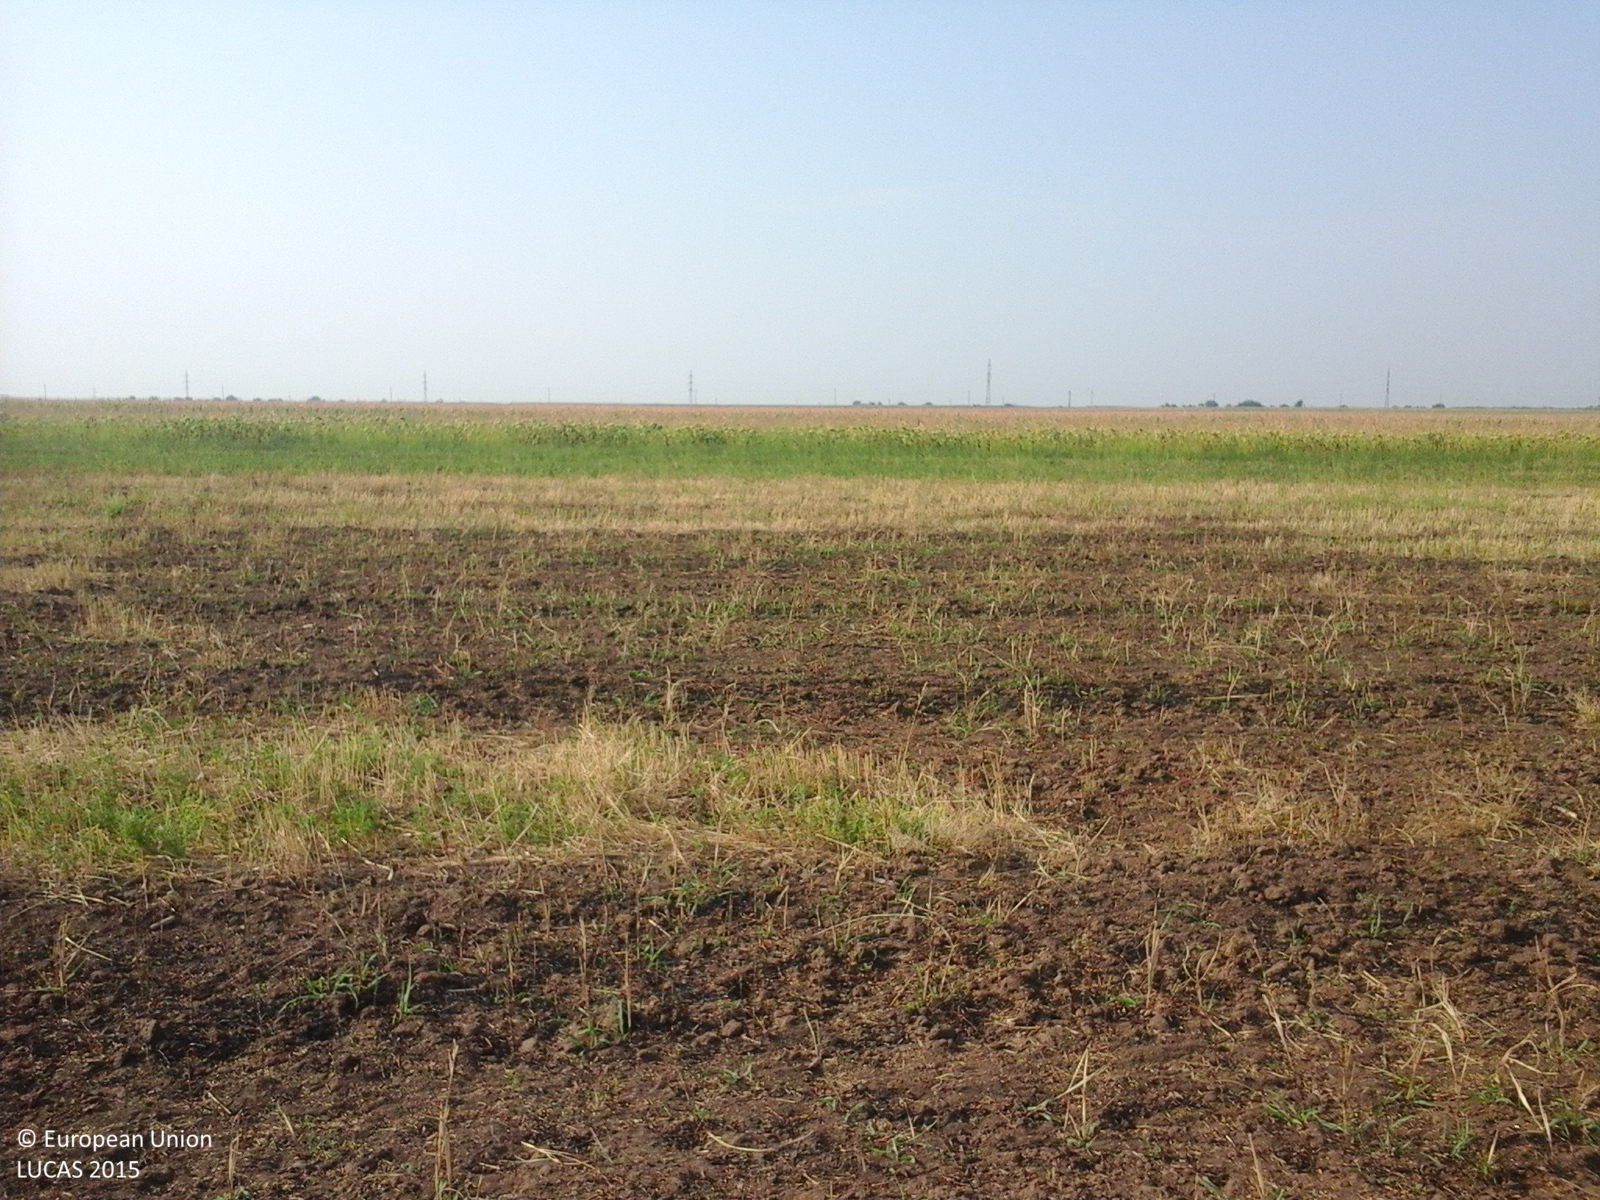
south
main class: Cropland
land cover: Common wheat
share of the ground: < 10 %
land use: Agriculture (excluding fallow land and kitchen gardens)
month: August
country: RO
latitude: 44.1578
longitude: 22.9335
